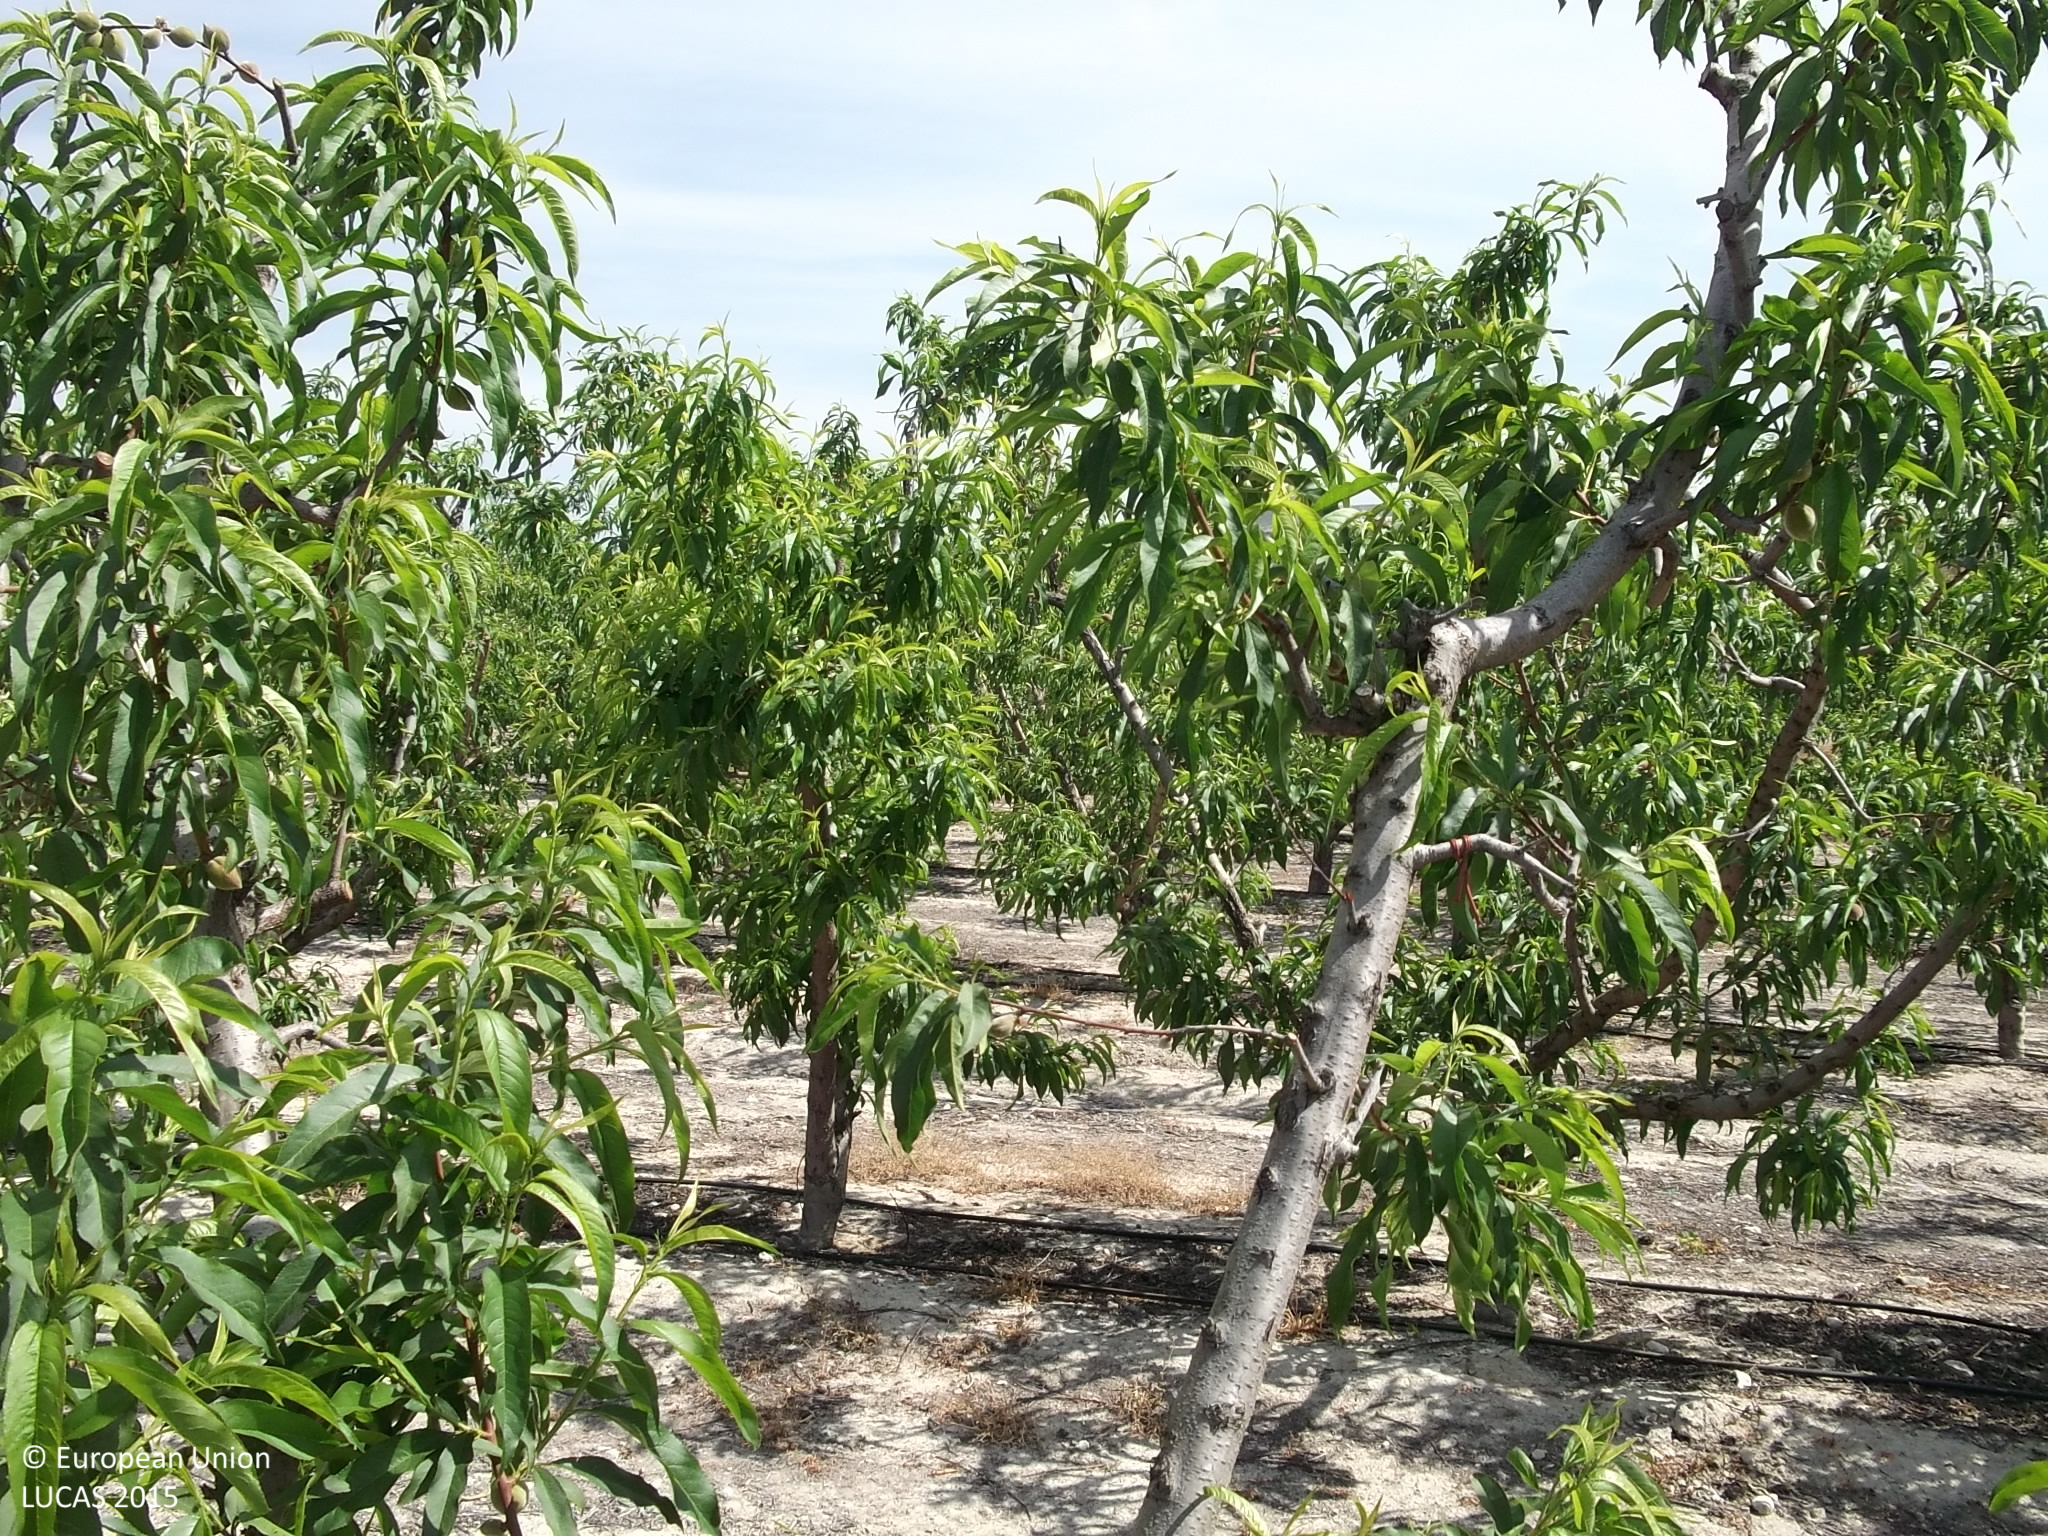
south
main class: Cropland
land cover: Other fruit trees and berries
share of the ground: 25 - 50 %
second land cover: Spontaneously vegetated surfaces
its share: 25 - 50 %
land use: Agriculture (excluding fallow land and kitchen gardens)
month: April
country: ES
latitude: 38.2759
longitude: -1.4773
